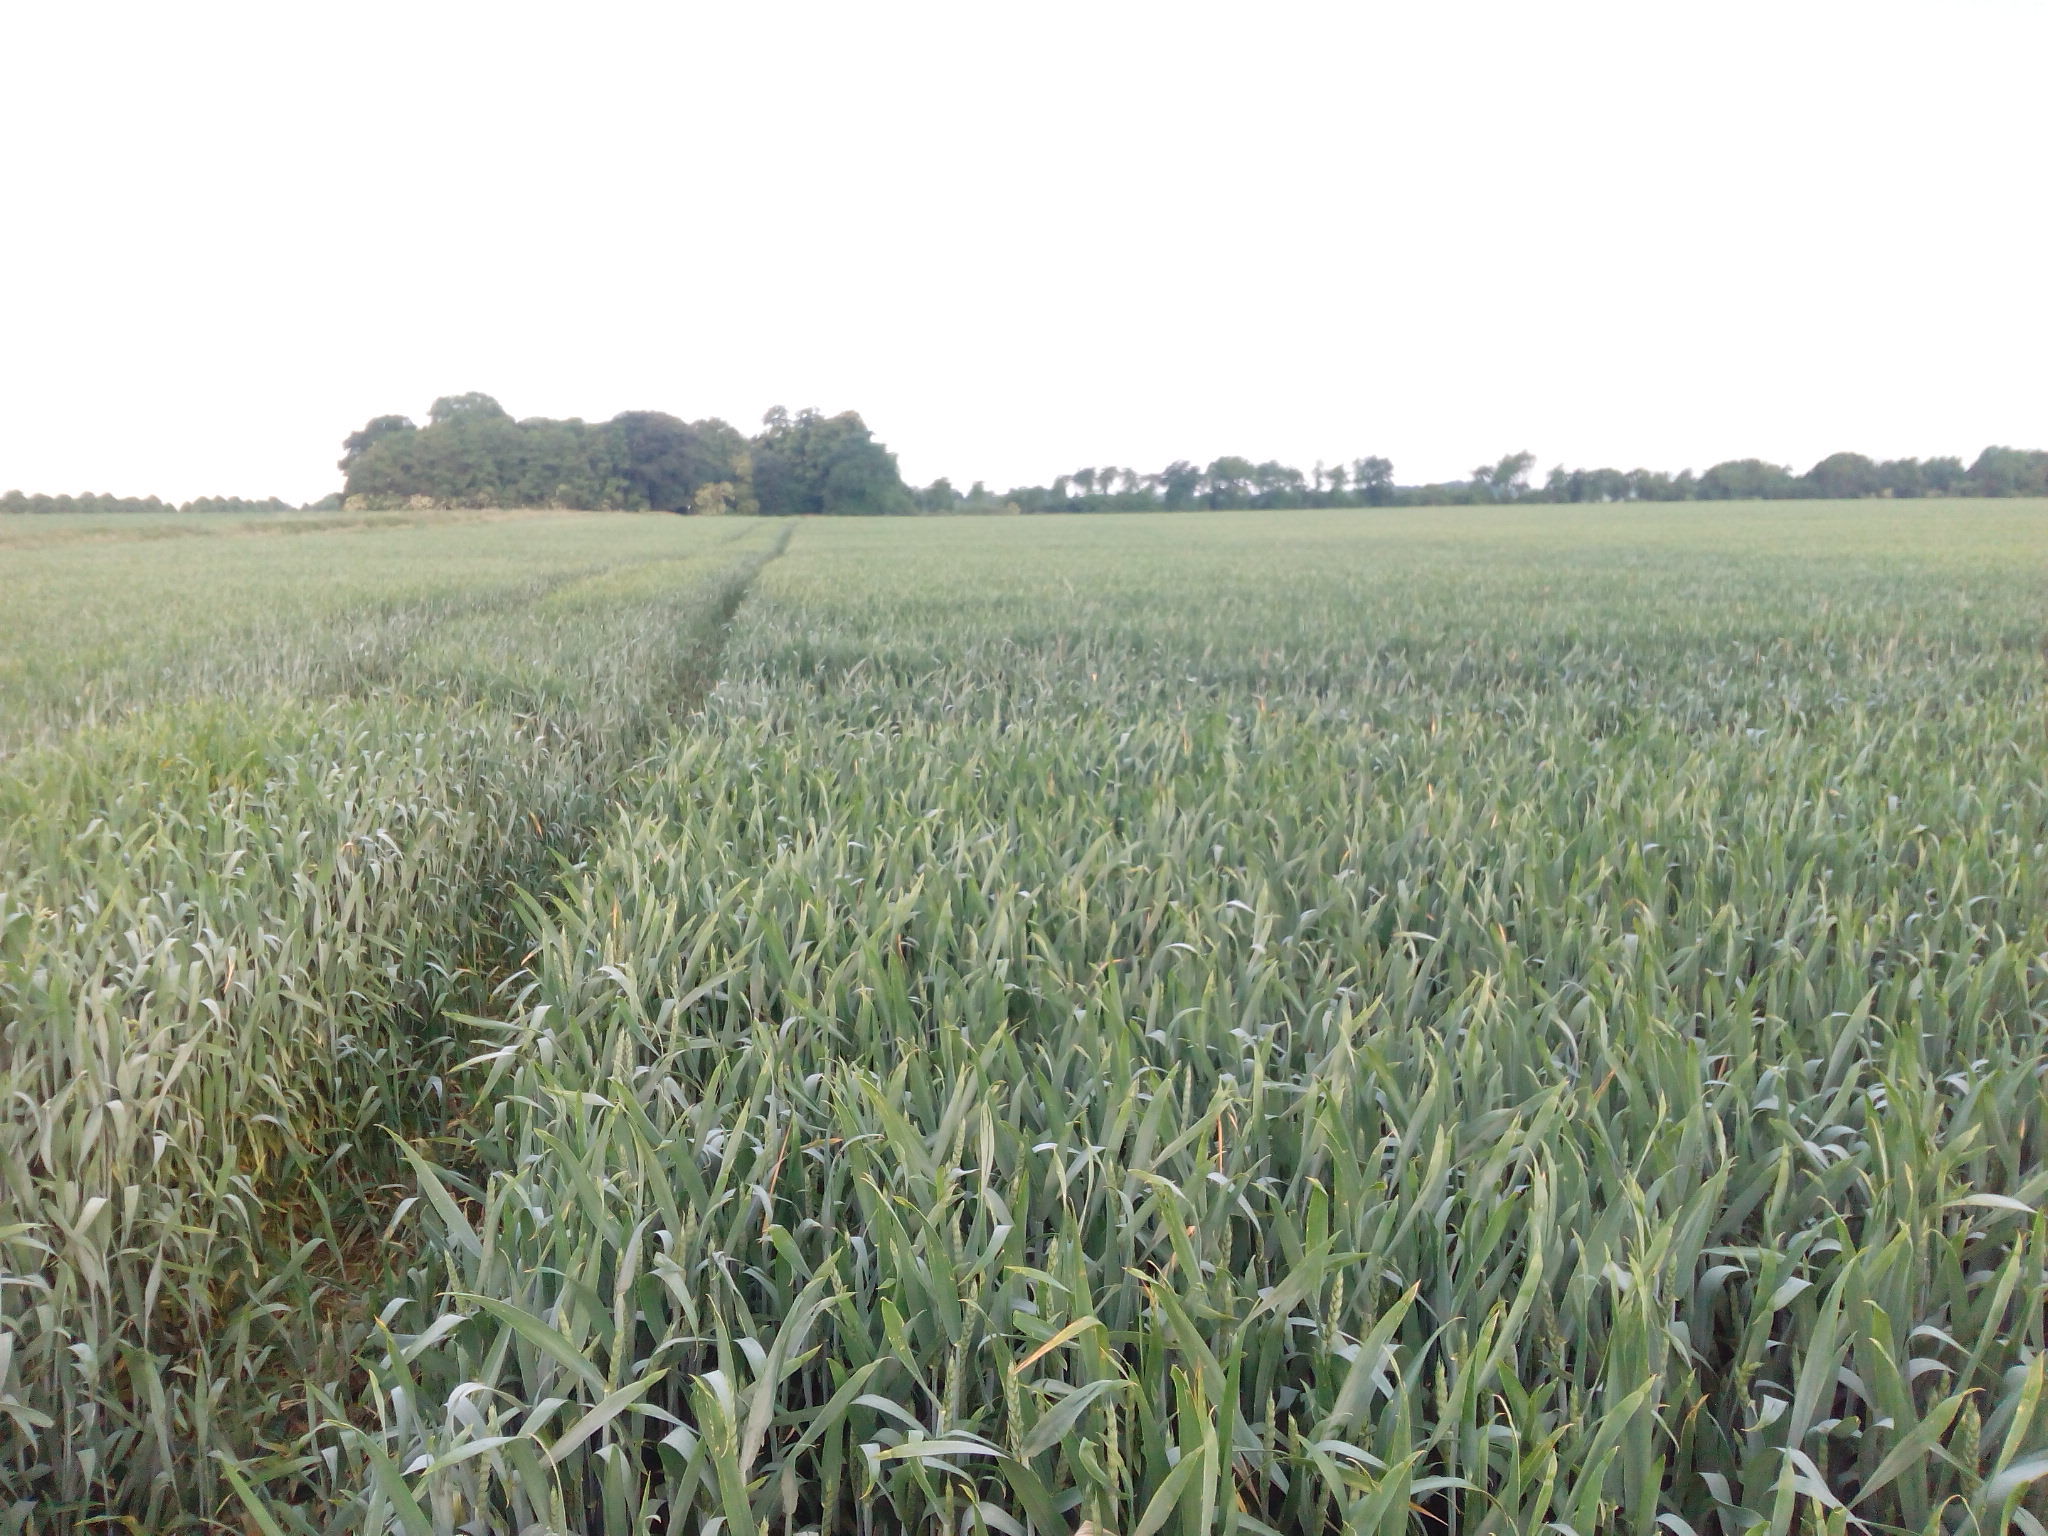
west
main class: Cropland
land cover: Common wheat
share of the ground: > 75 %
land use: Agriculture (excluding fallow land and kitchen gardens)
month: June
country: DE
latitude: 52.3589
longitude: 9.6330
